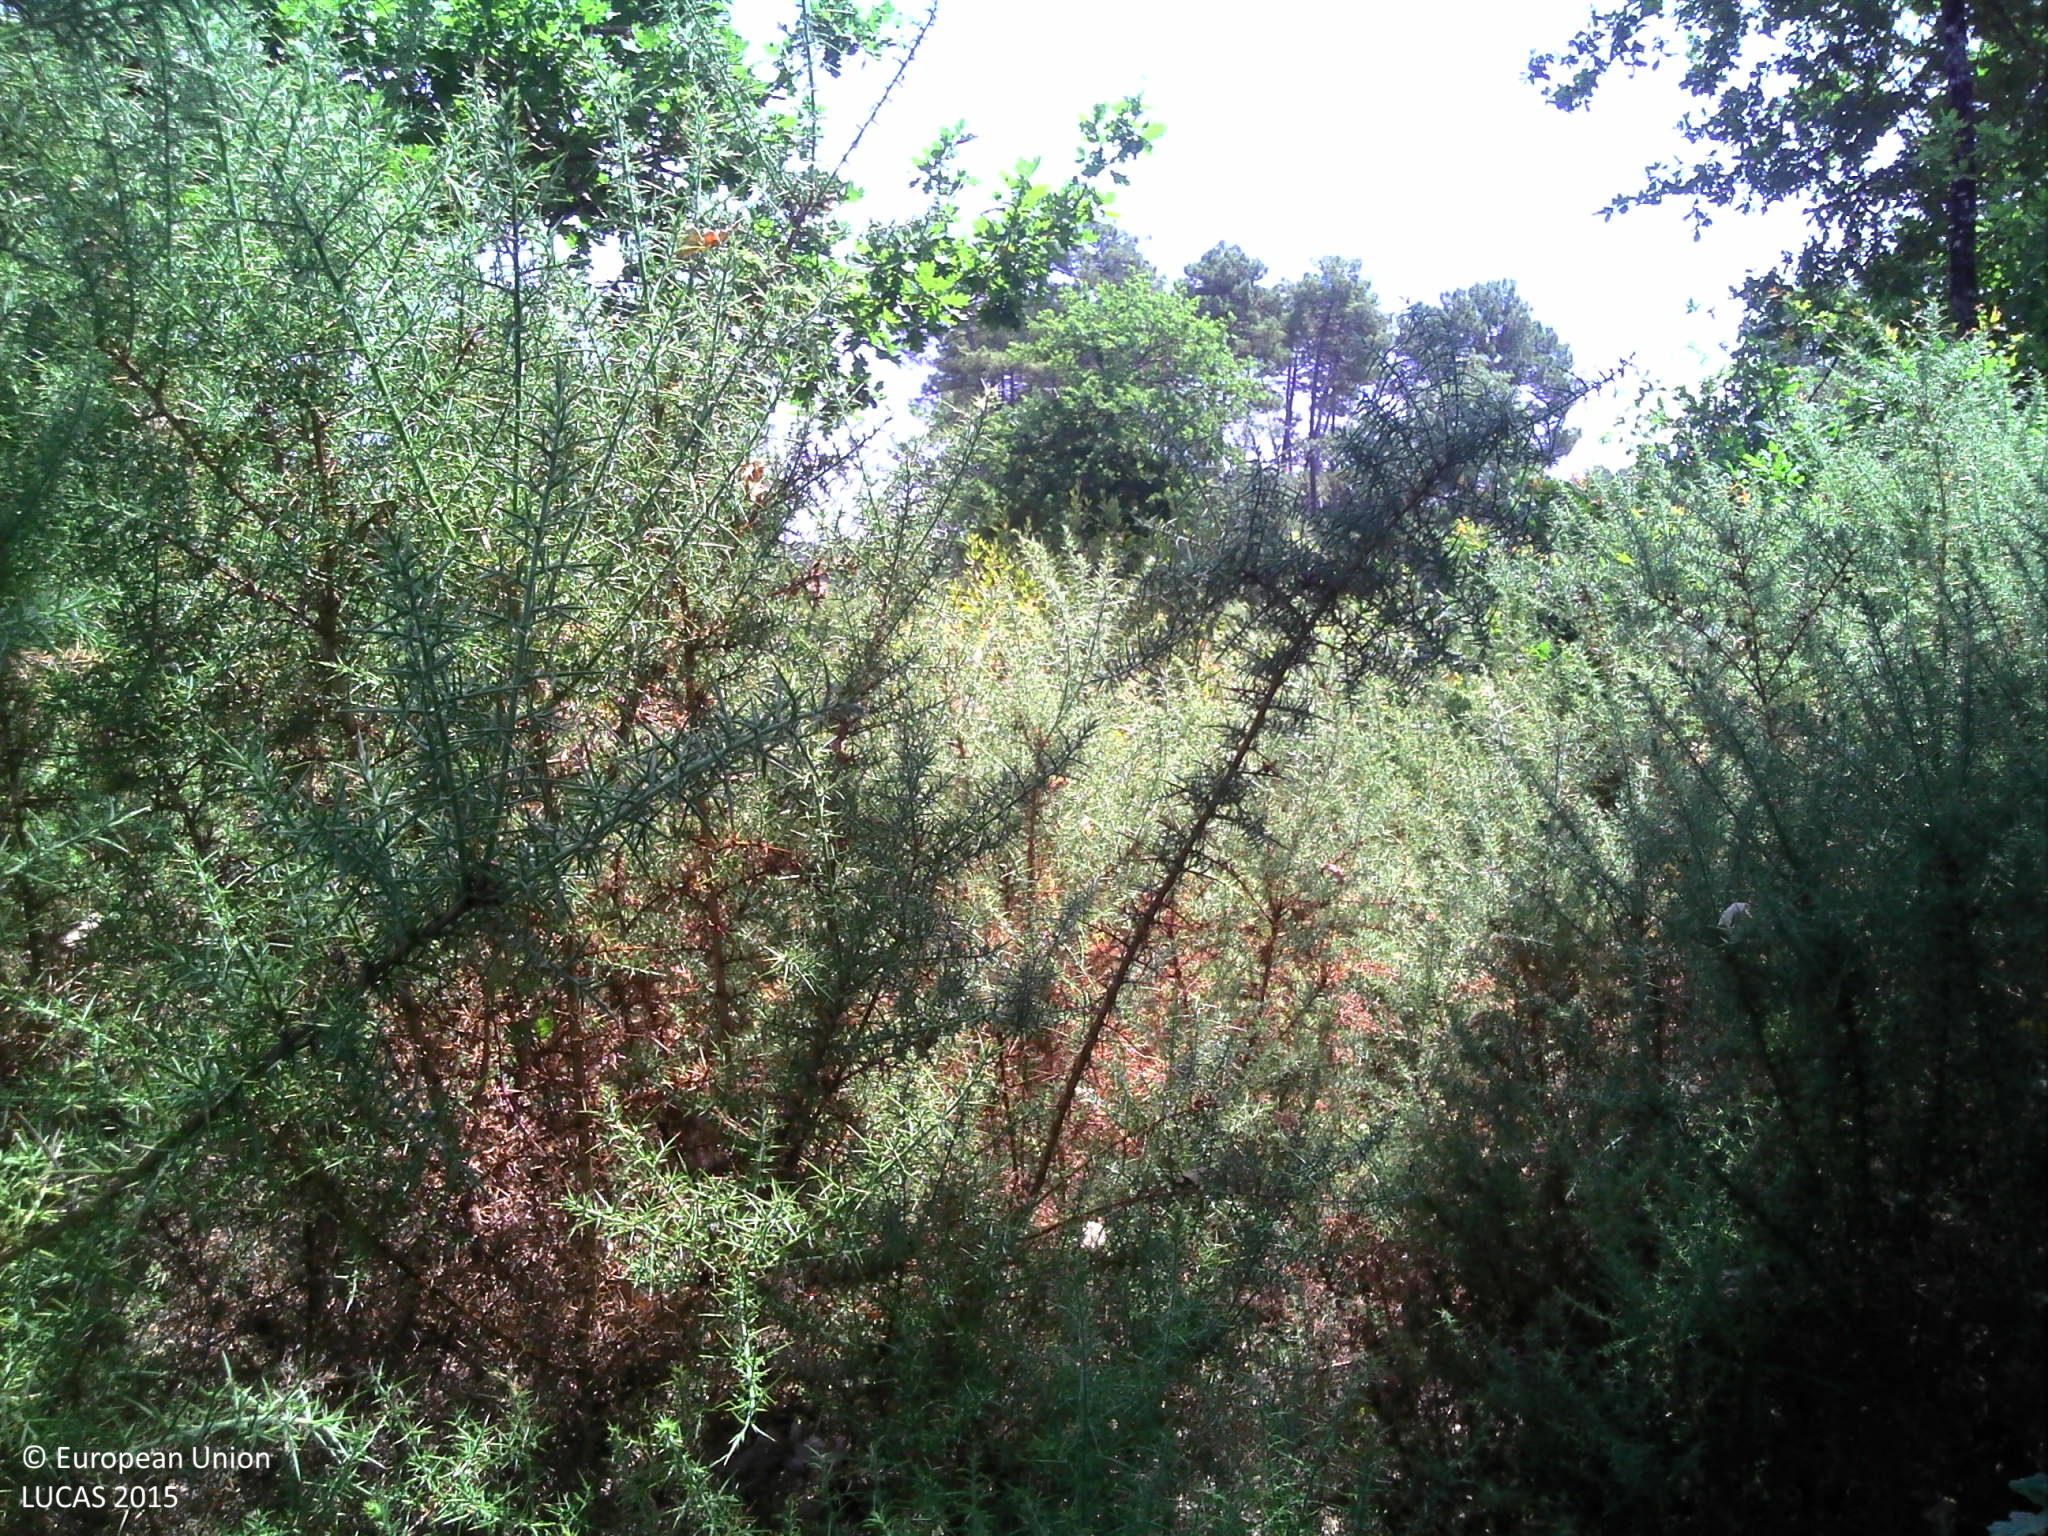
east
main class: Woodland
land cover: Broadleaved woodland
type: thermophilous deciduous forest
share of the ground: > 75 %
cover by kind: broadleaved forest trees 85 %, coniferous forest trees 5 %, shrubs 5 %, herbaceous plants 5 %
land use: Semi-natural and natural areas not in use
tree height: < 5 m
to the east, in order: Broadleaved woodland; Ditches and canals; Spontaneously vegetated surfaces; Tracks; Fences; Spontaneously vegetated surfaces; Fences; Spontaneously vegetated surfaces; Tracks; Abandoned hedges; Pine dominated coniferous woodland; Other bare soil; Pine dominated coniferous woodland
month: July
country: FR
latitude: 44.3803
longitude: -0.6727
